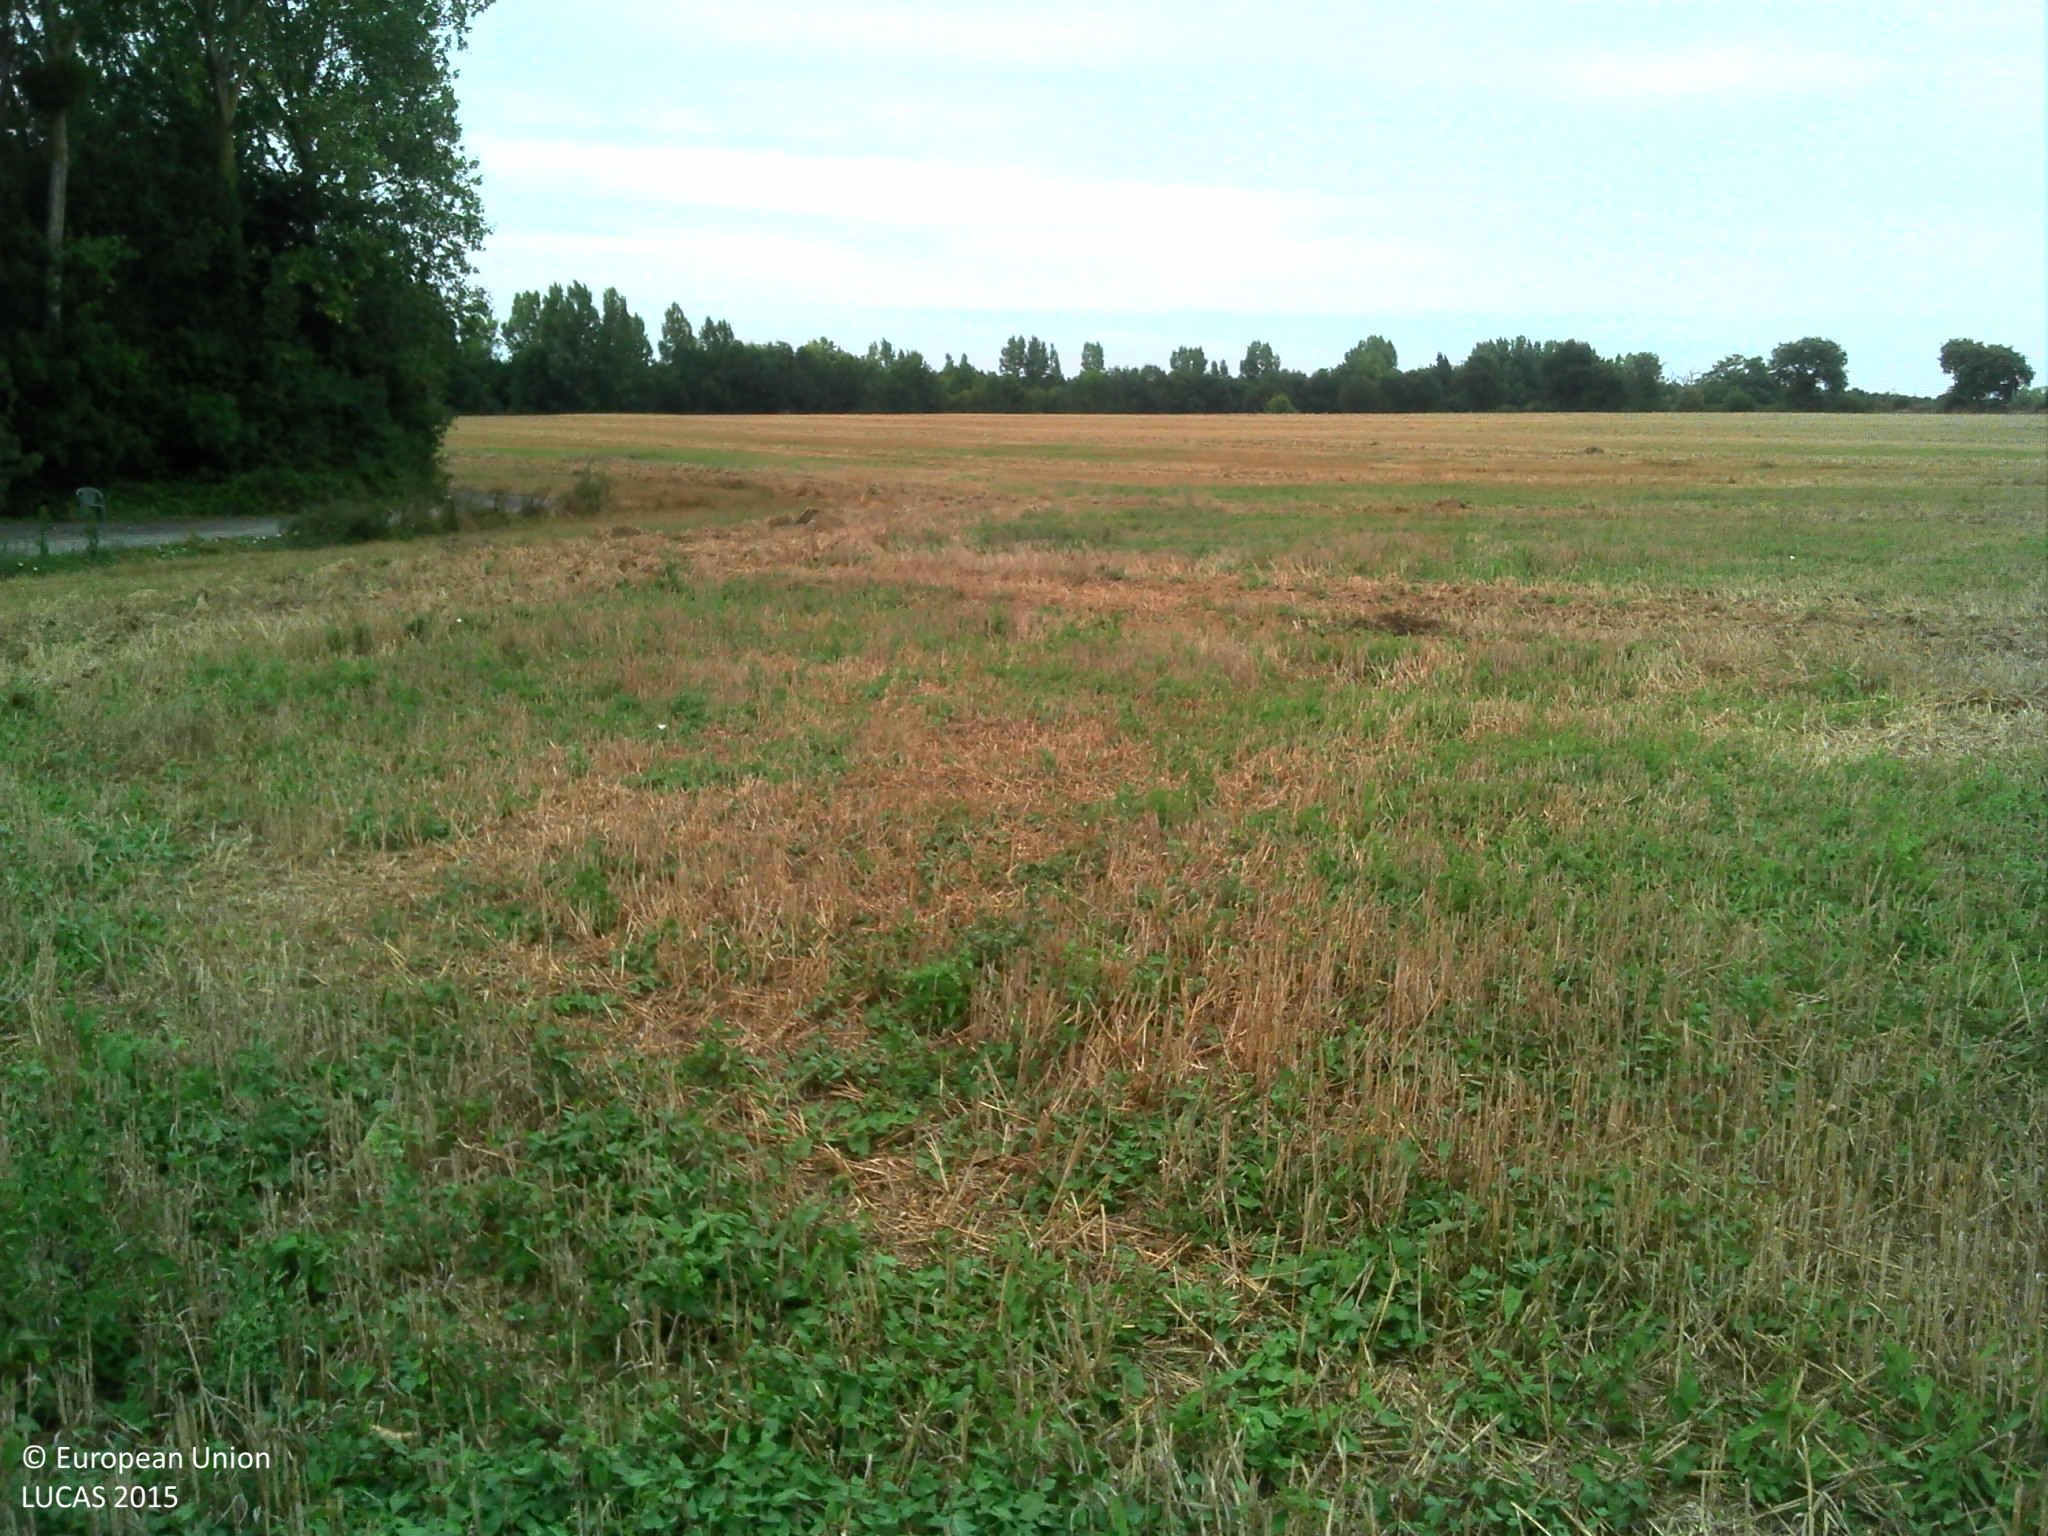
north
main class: Cropland
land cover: Common wheat
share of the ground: > 75 %
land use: Agriculture (excluding fallow land and kitchen gardens)
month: July
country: FR
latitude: 46.8093
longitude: -1.0816
